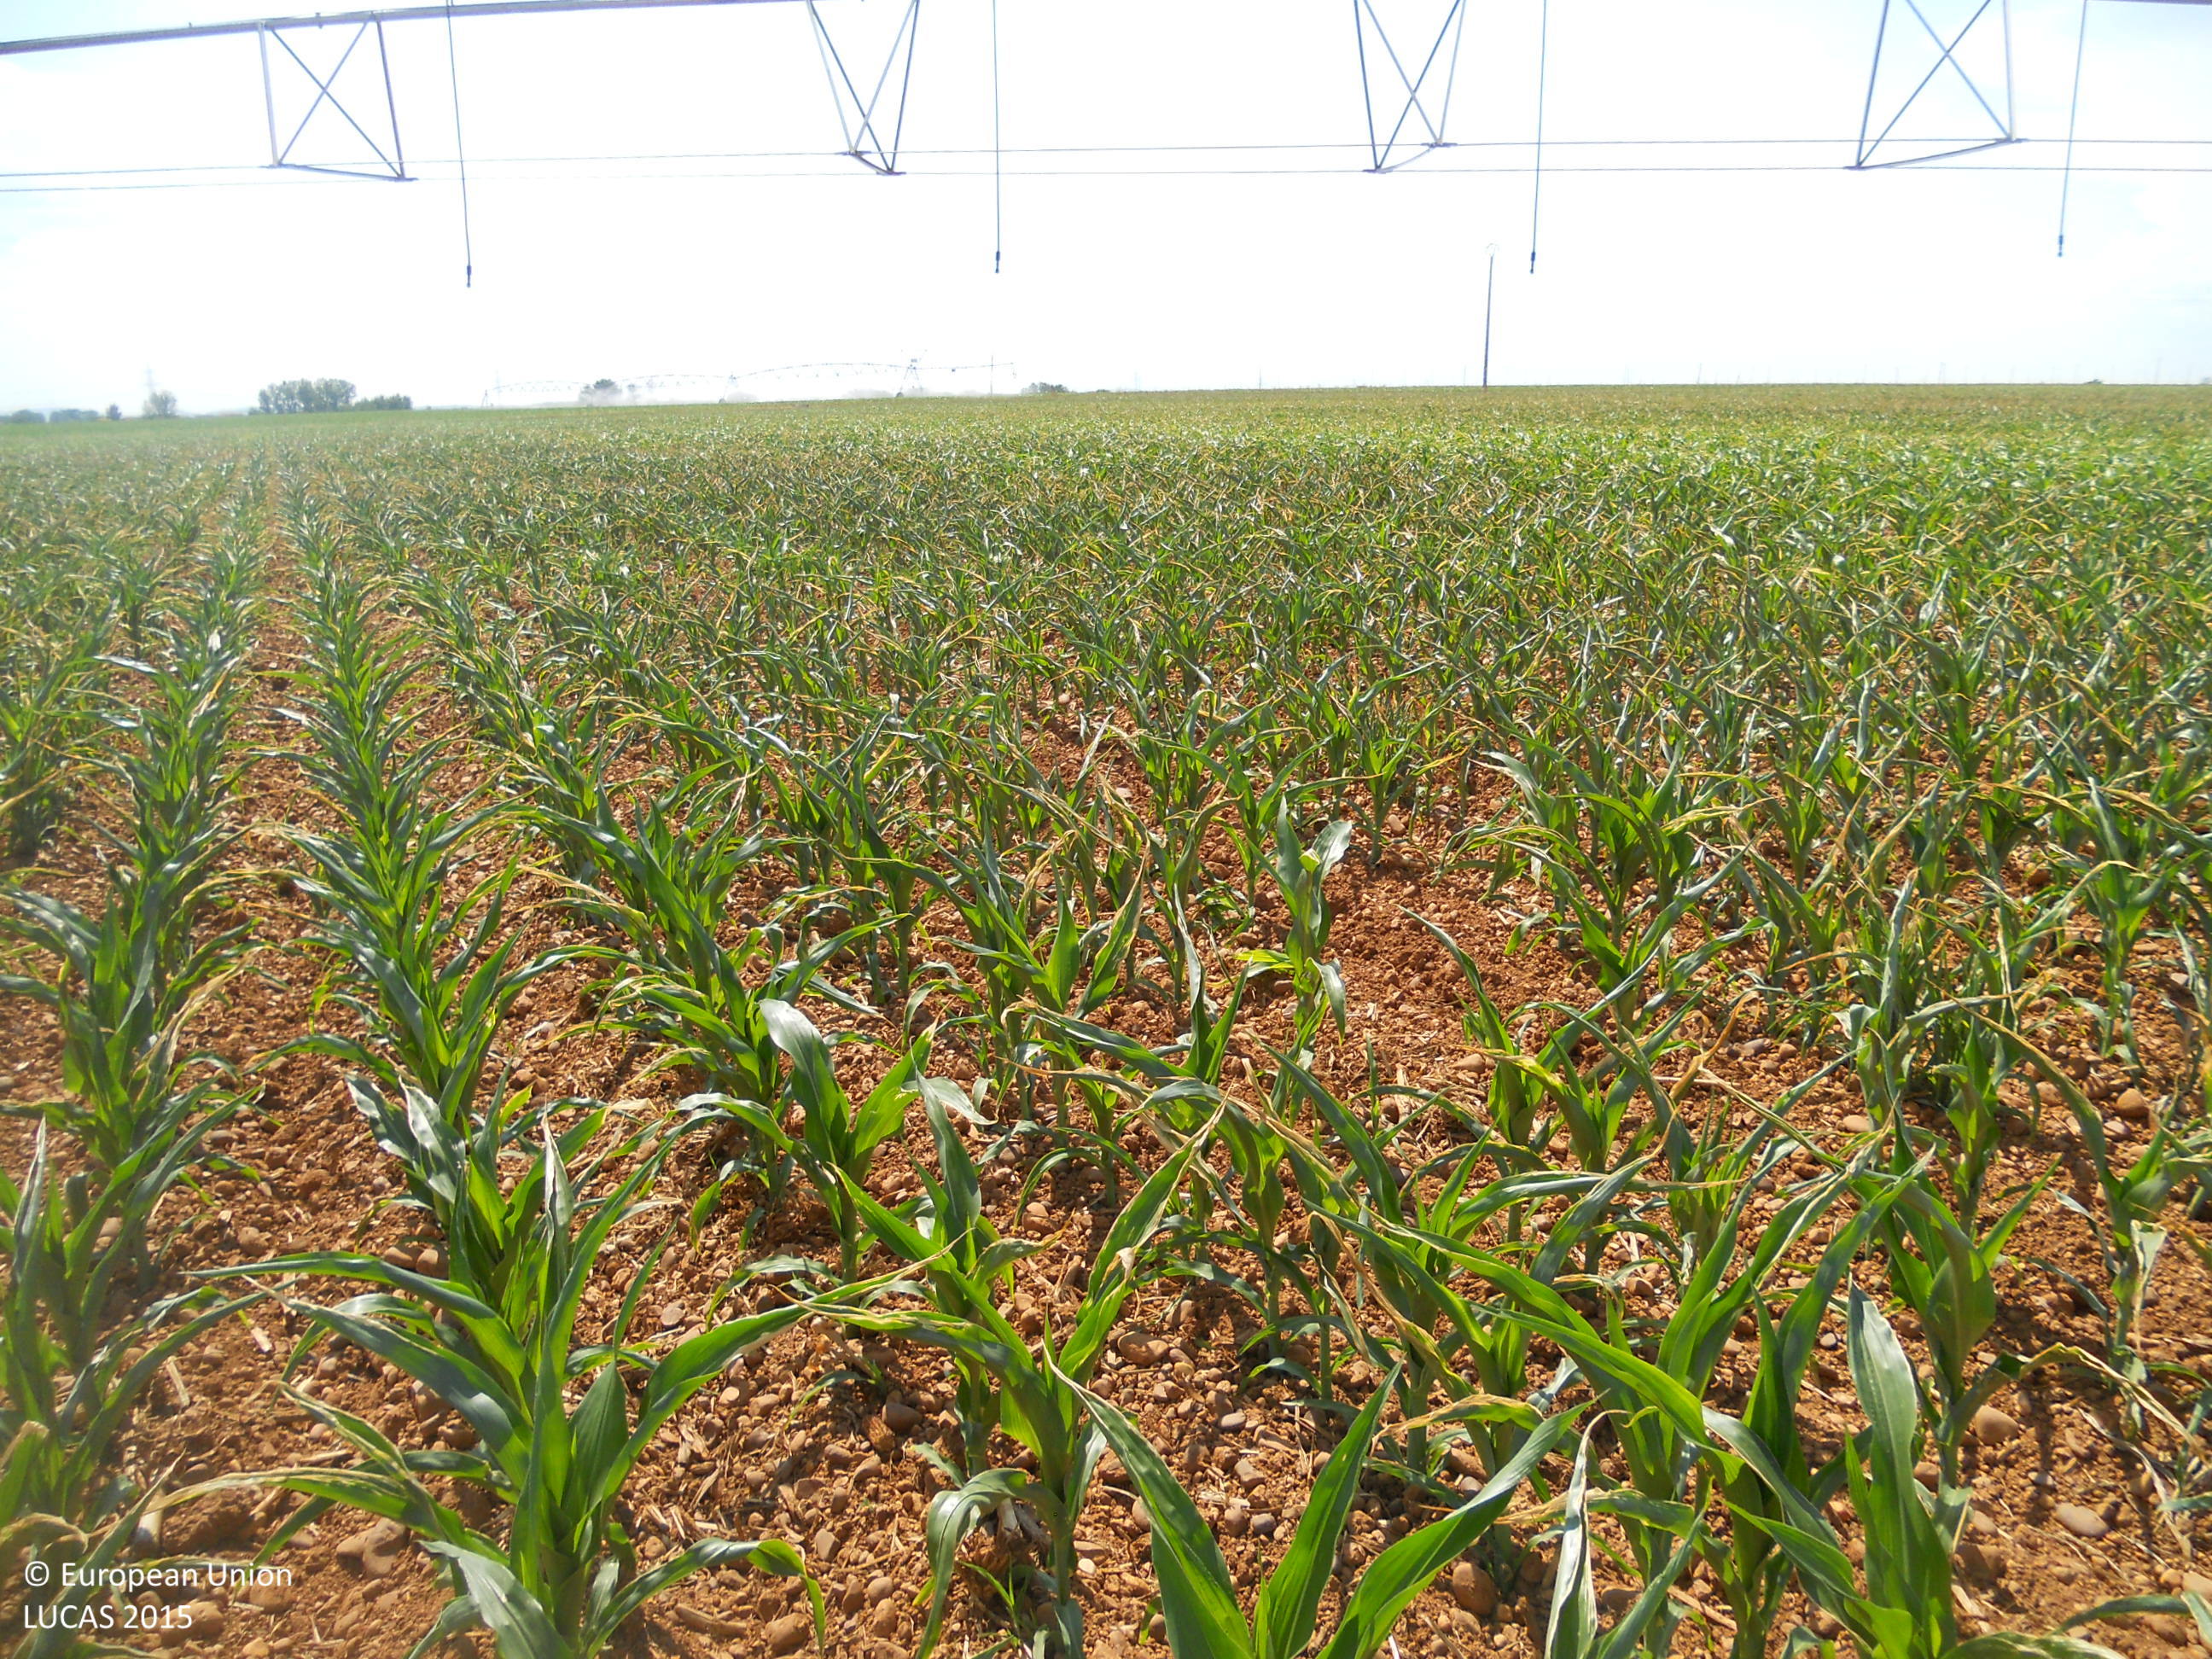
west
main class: Cropland
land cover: Maize
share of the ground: > 75 %
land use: Agriculture (excluding fallow land and kitchen gardens)
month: June
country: ES
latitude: 42.1989
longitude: -5.6560
